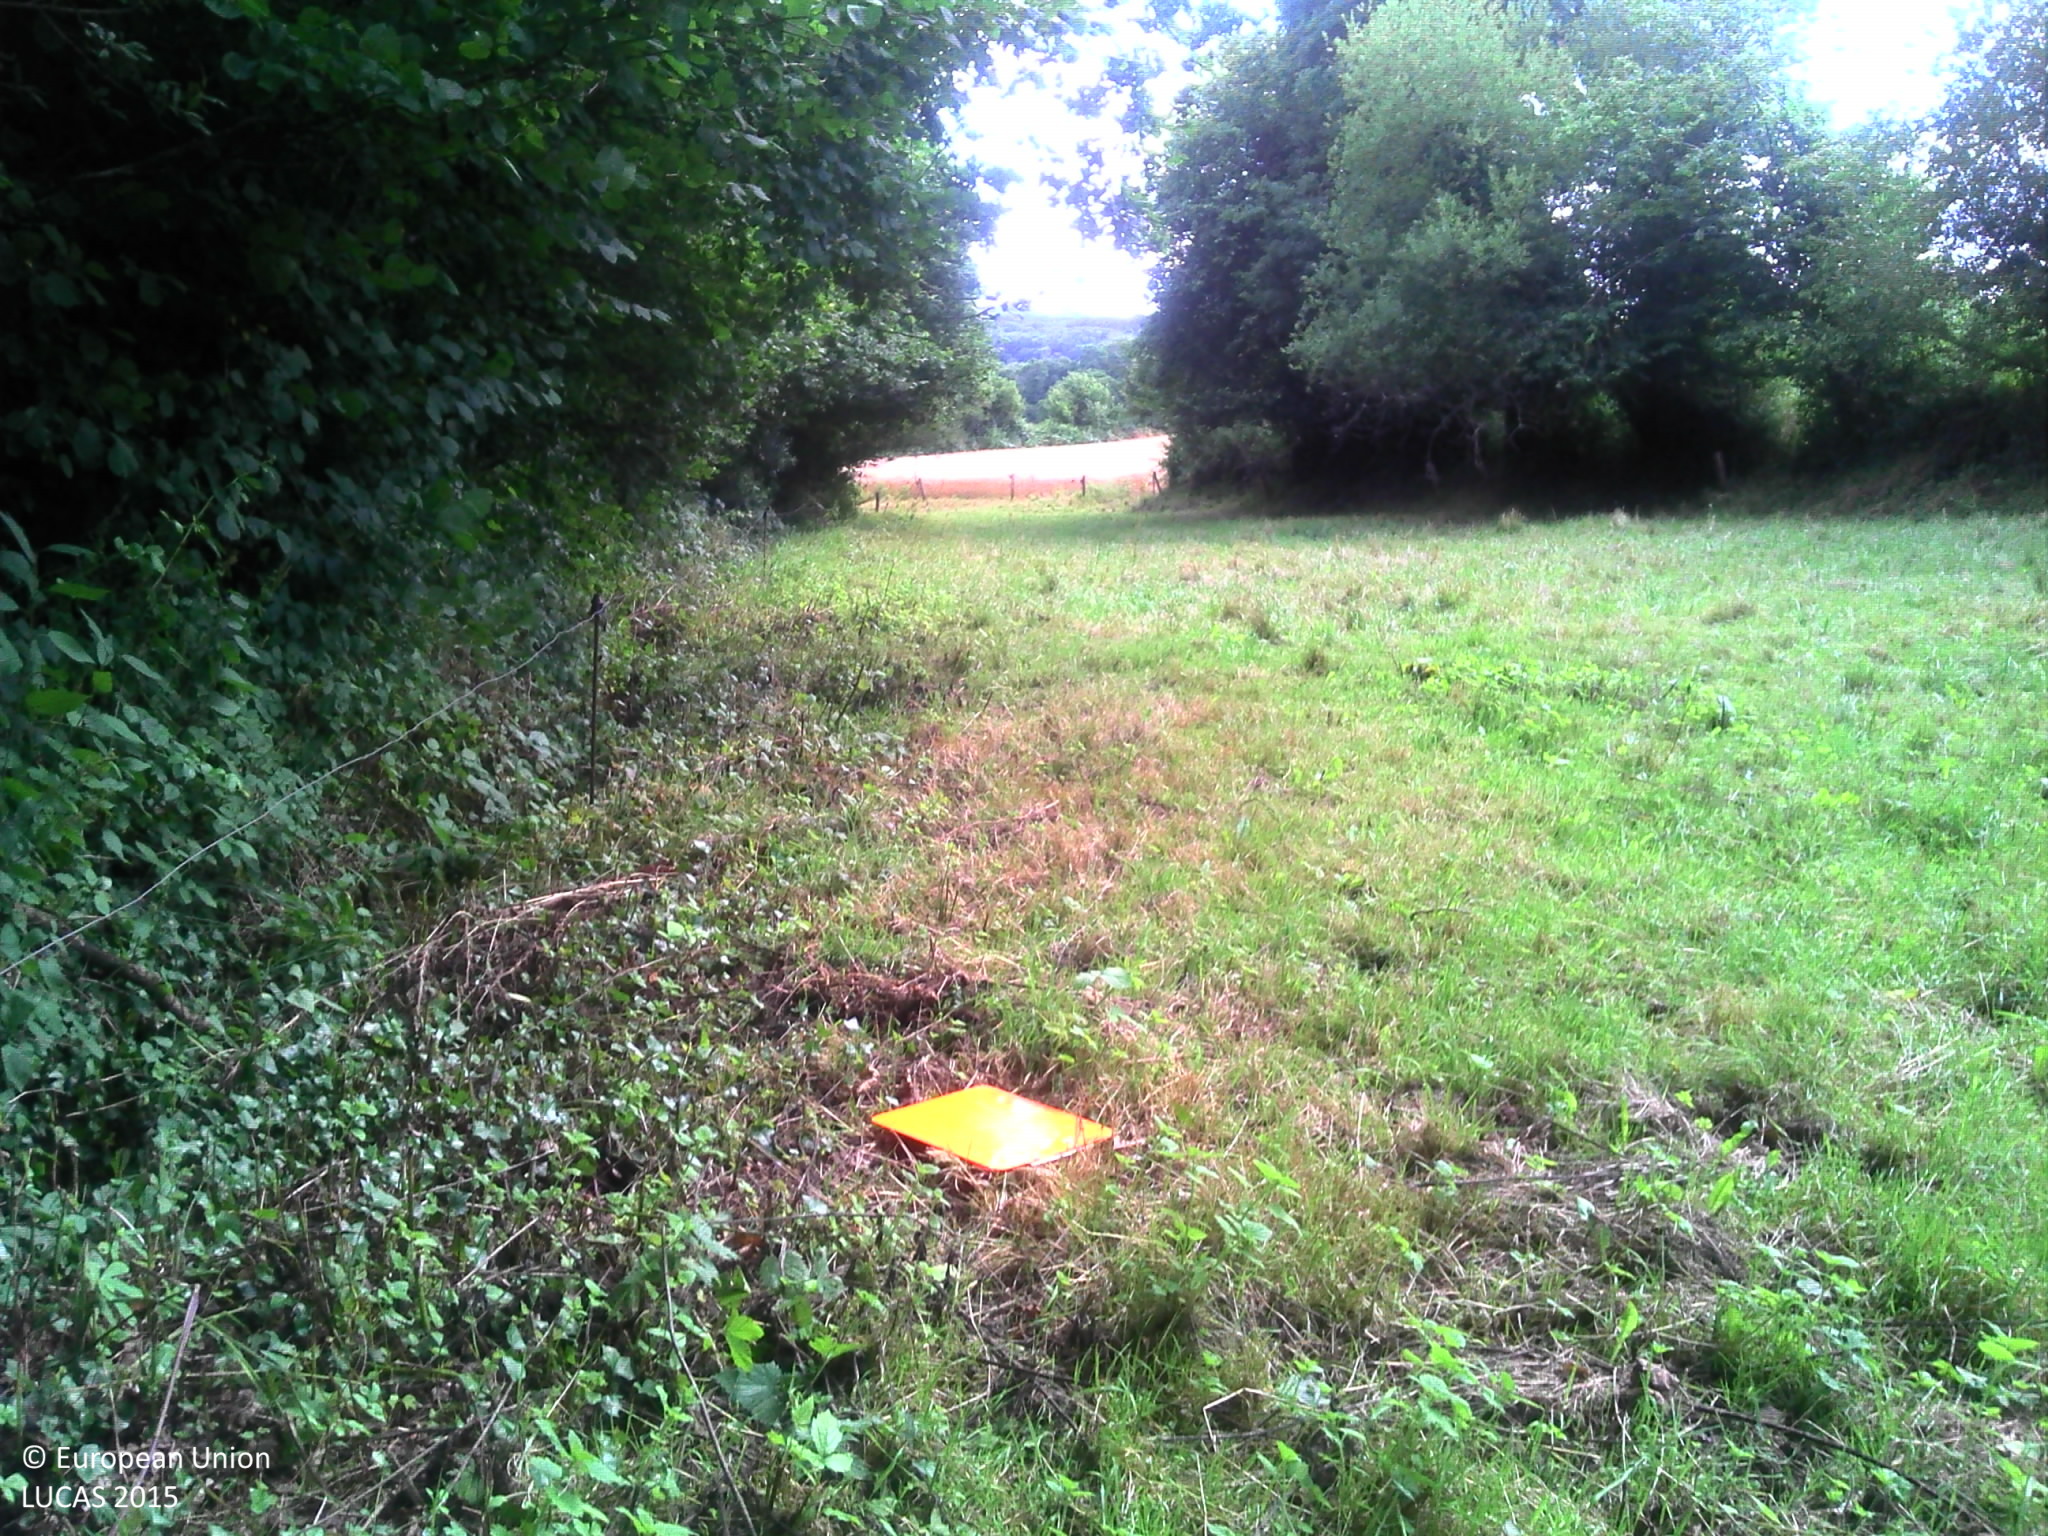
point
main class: Grassland
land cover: Grassland without tree/shrub cover
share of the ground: > 75 %
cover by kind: herbaceous plants 100 %
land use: Agriculture (excluding fallow land and kitchen gardens)
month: July
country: FR
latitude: 48.5087
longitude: -3.4379
